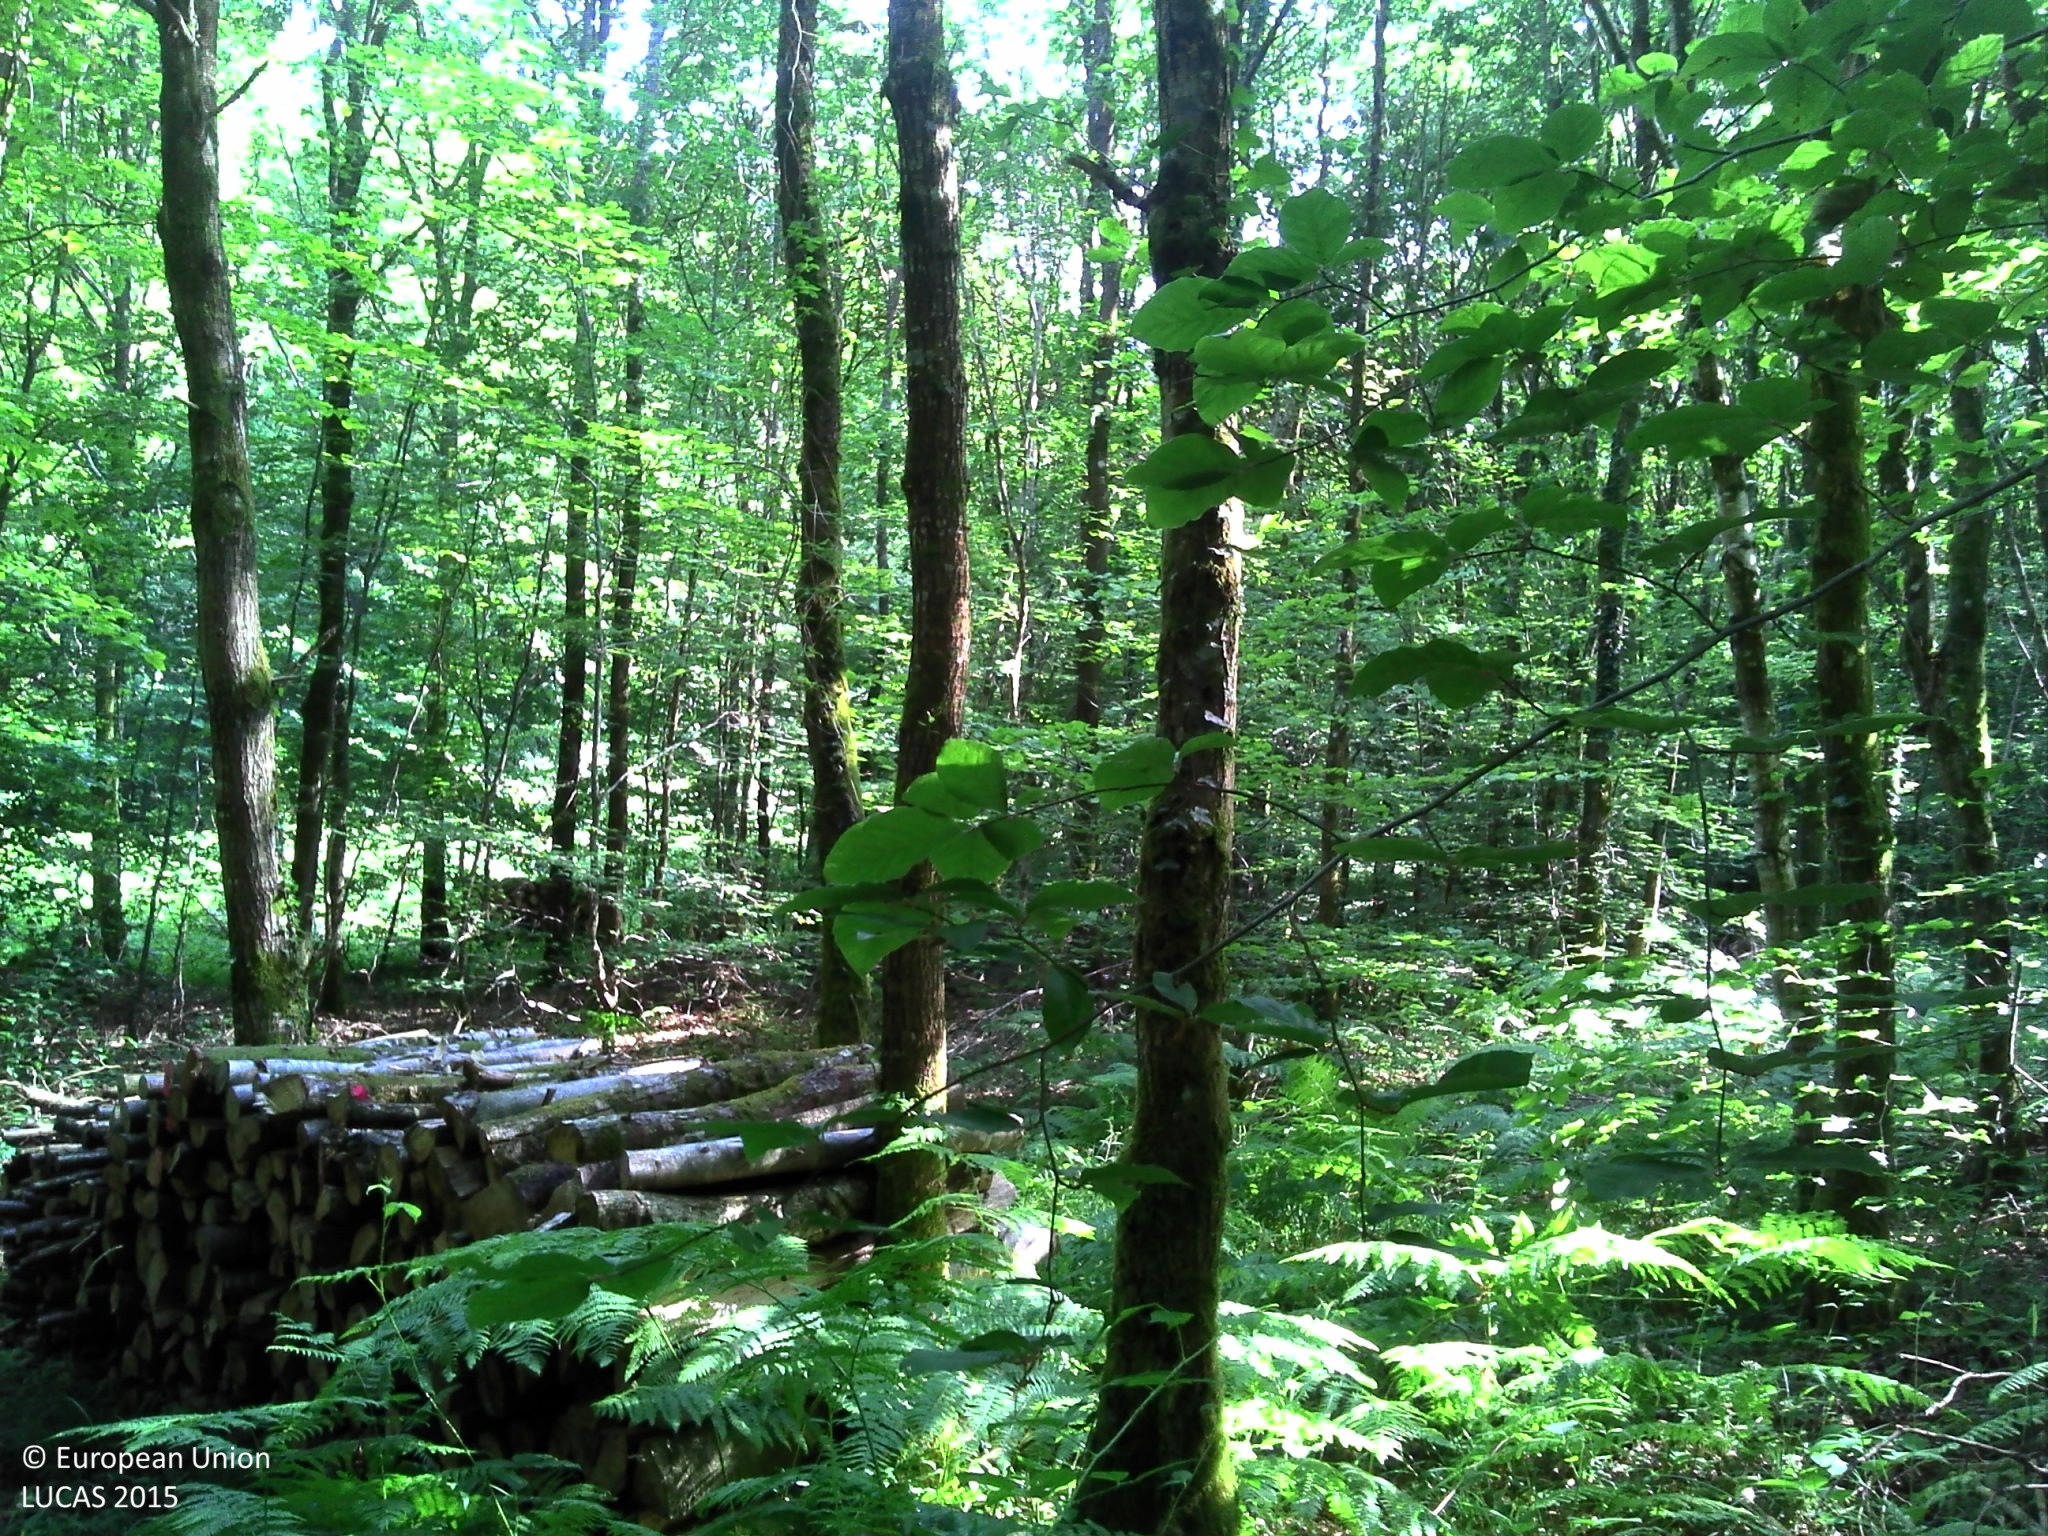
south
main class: Woodland
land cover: Broadleaved woodland
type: beech forest
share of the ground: > 75 %
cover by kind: broadleaved forest trees 75 %, herbaceous plants 15 %, shrubs 10 %
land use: Forestry
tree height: > 5 m
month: June
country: FR
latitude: 48.4051
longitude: 0.2333
